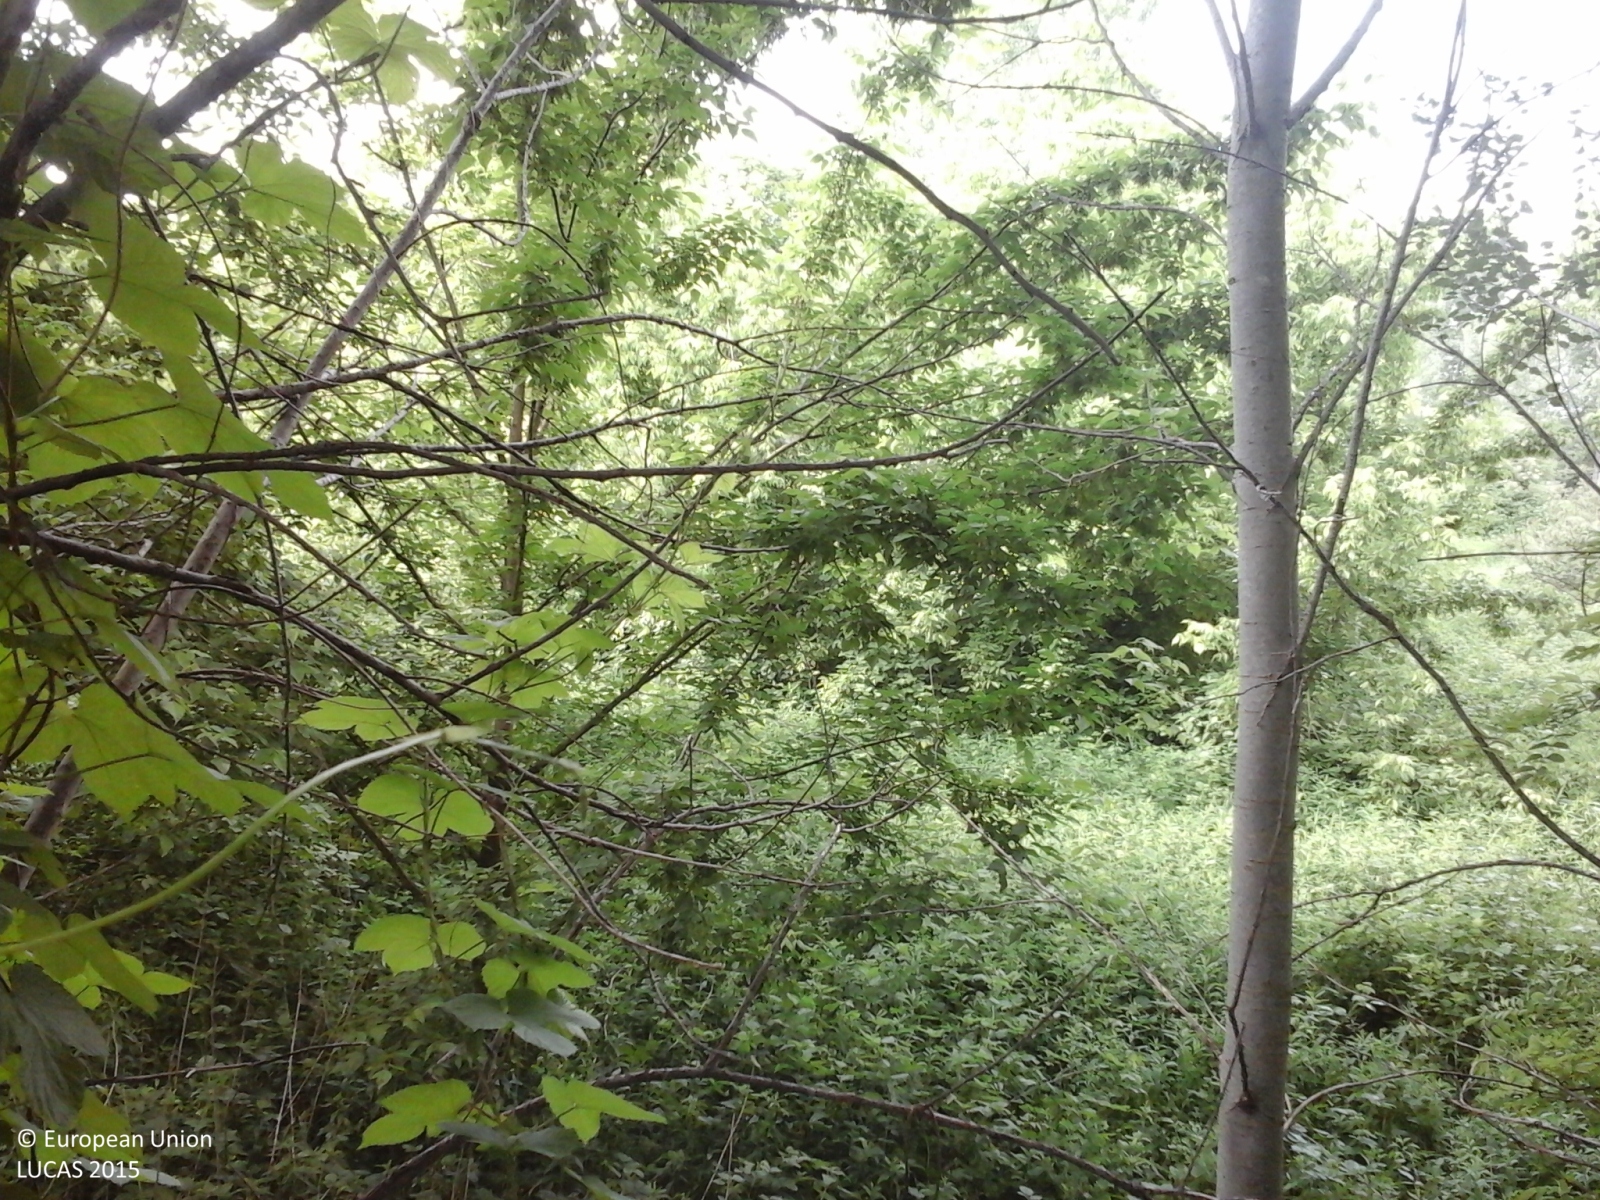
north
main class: Grassland
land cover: Grassland with sparse tree/shrub cover
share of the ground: > 75 %
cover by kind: herbaceous plants 85 %, shrubs 10 %, broadleaved forest trees 5 %
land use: Semi-natural and natural areas not in use
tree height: < 5 m
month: May
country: IT
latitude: 44.9021
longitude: 7.6867
